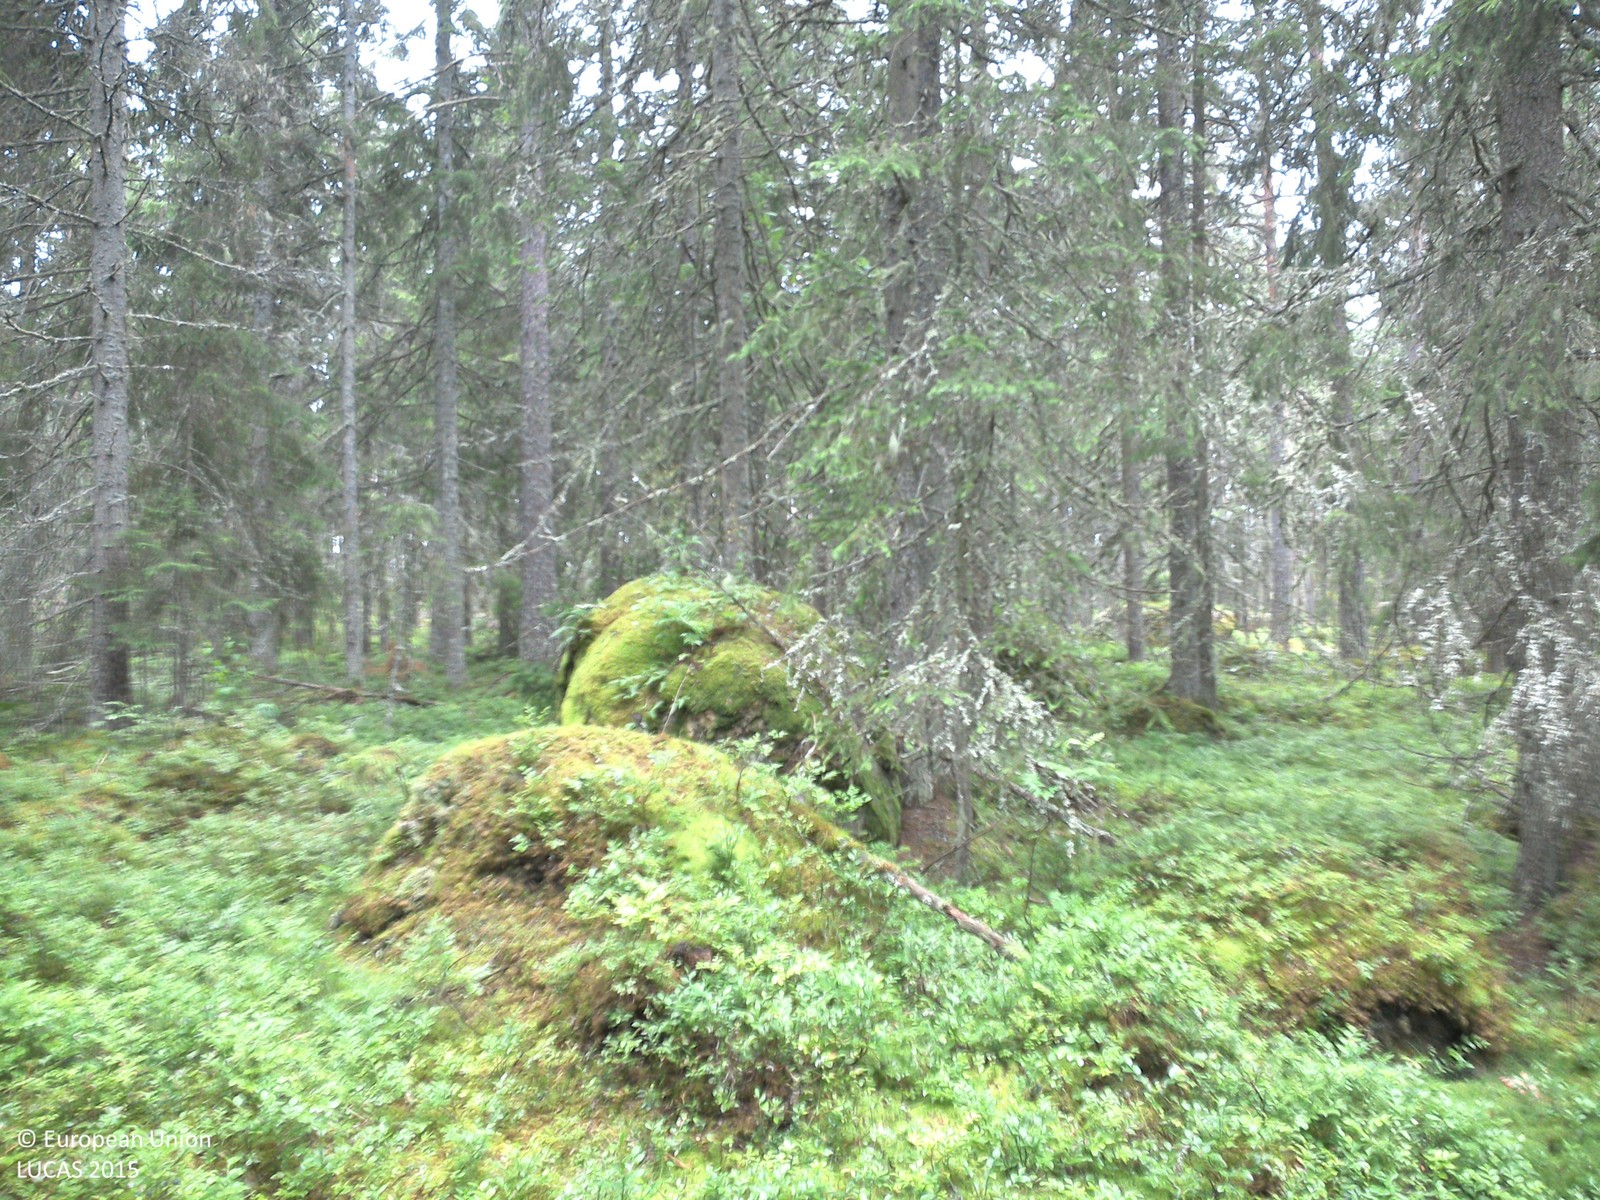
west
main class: Woodland
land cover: Spruce dominated coniferous woodland
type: boreal forest
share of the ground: > 75 %
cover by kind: coniferous forest trees 75 %, lichens and mosses 20 %, herbaceous plants 5 %
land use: Forestry
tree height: > 5 m
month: July
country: SE
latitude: 57.7654
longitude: 15.8970
